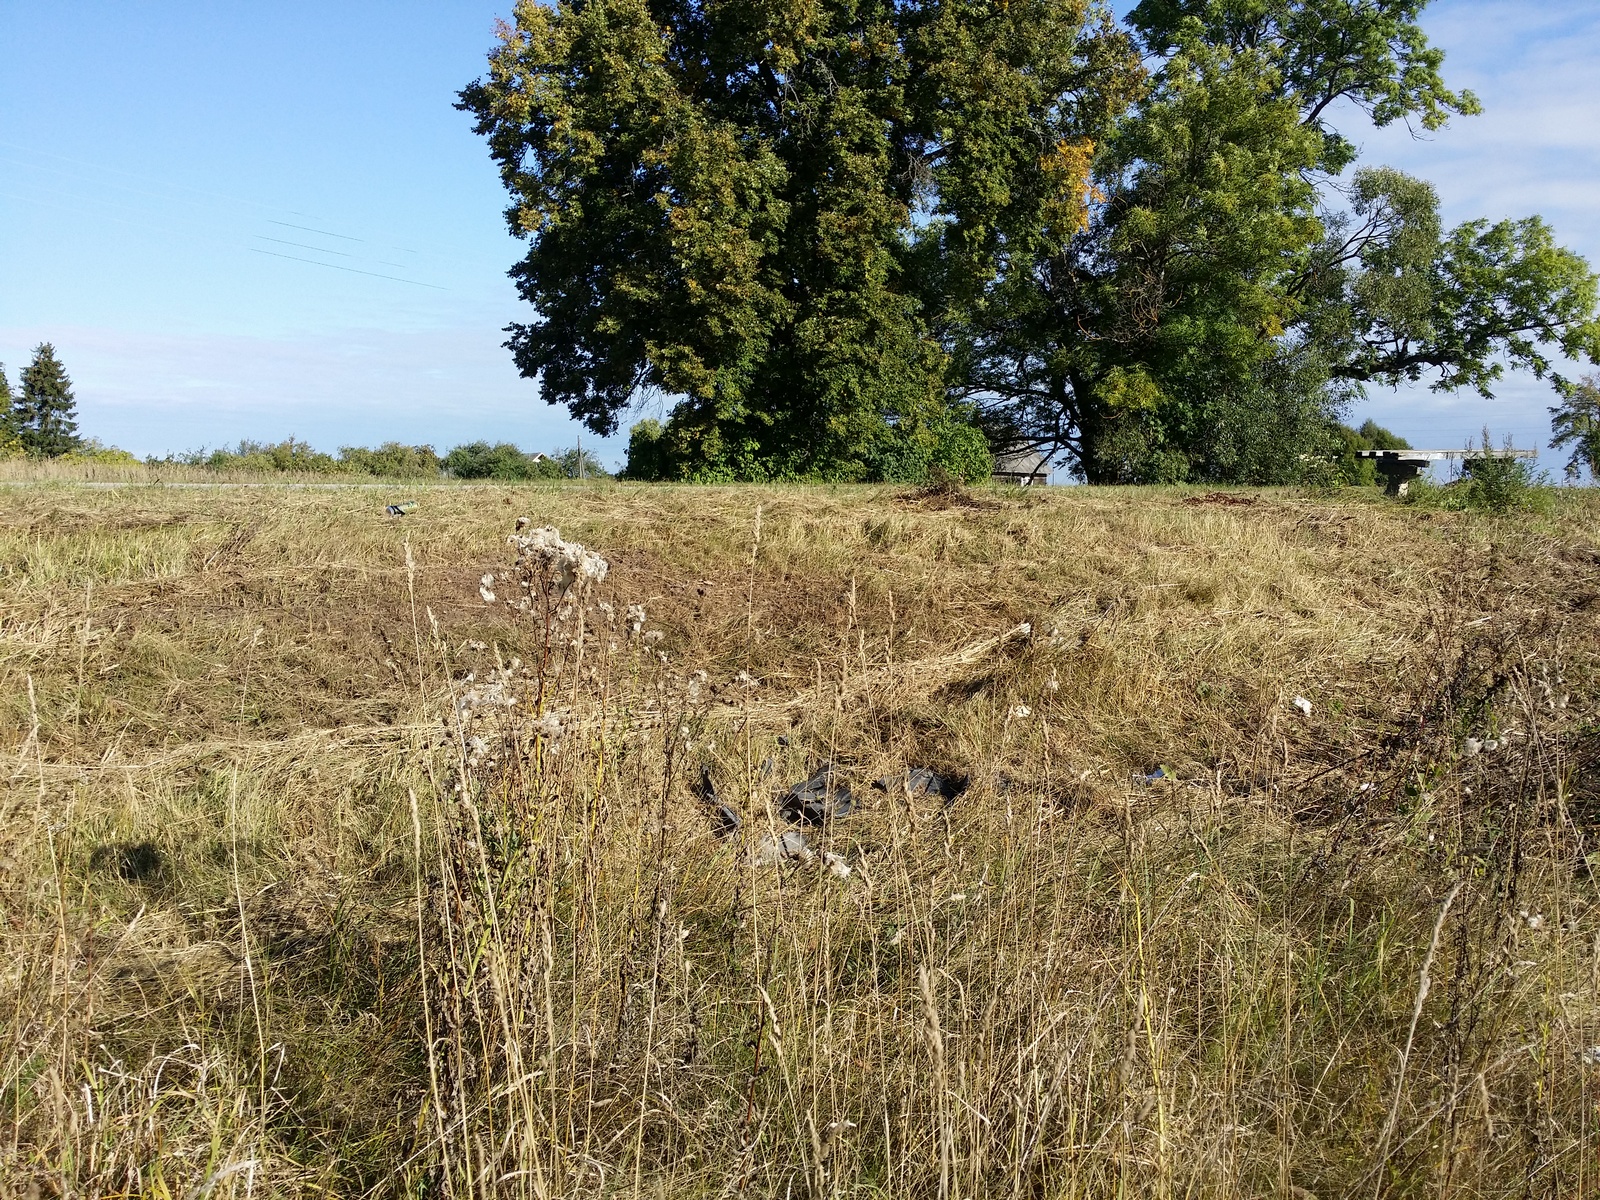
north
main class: Grassland
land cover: Grassland without tree/shrub cover
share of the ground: > 75 %
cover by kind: herbaceous plants 100 %
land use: Agriculture (excluding fallow land and kitchen gardens)
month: September
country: LV
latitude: 57.1731
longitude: 27.5952
